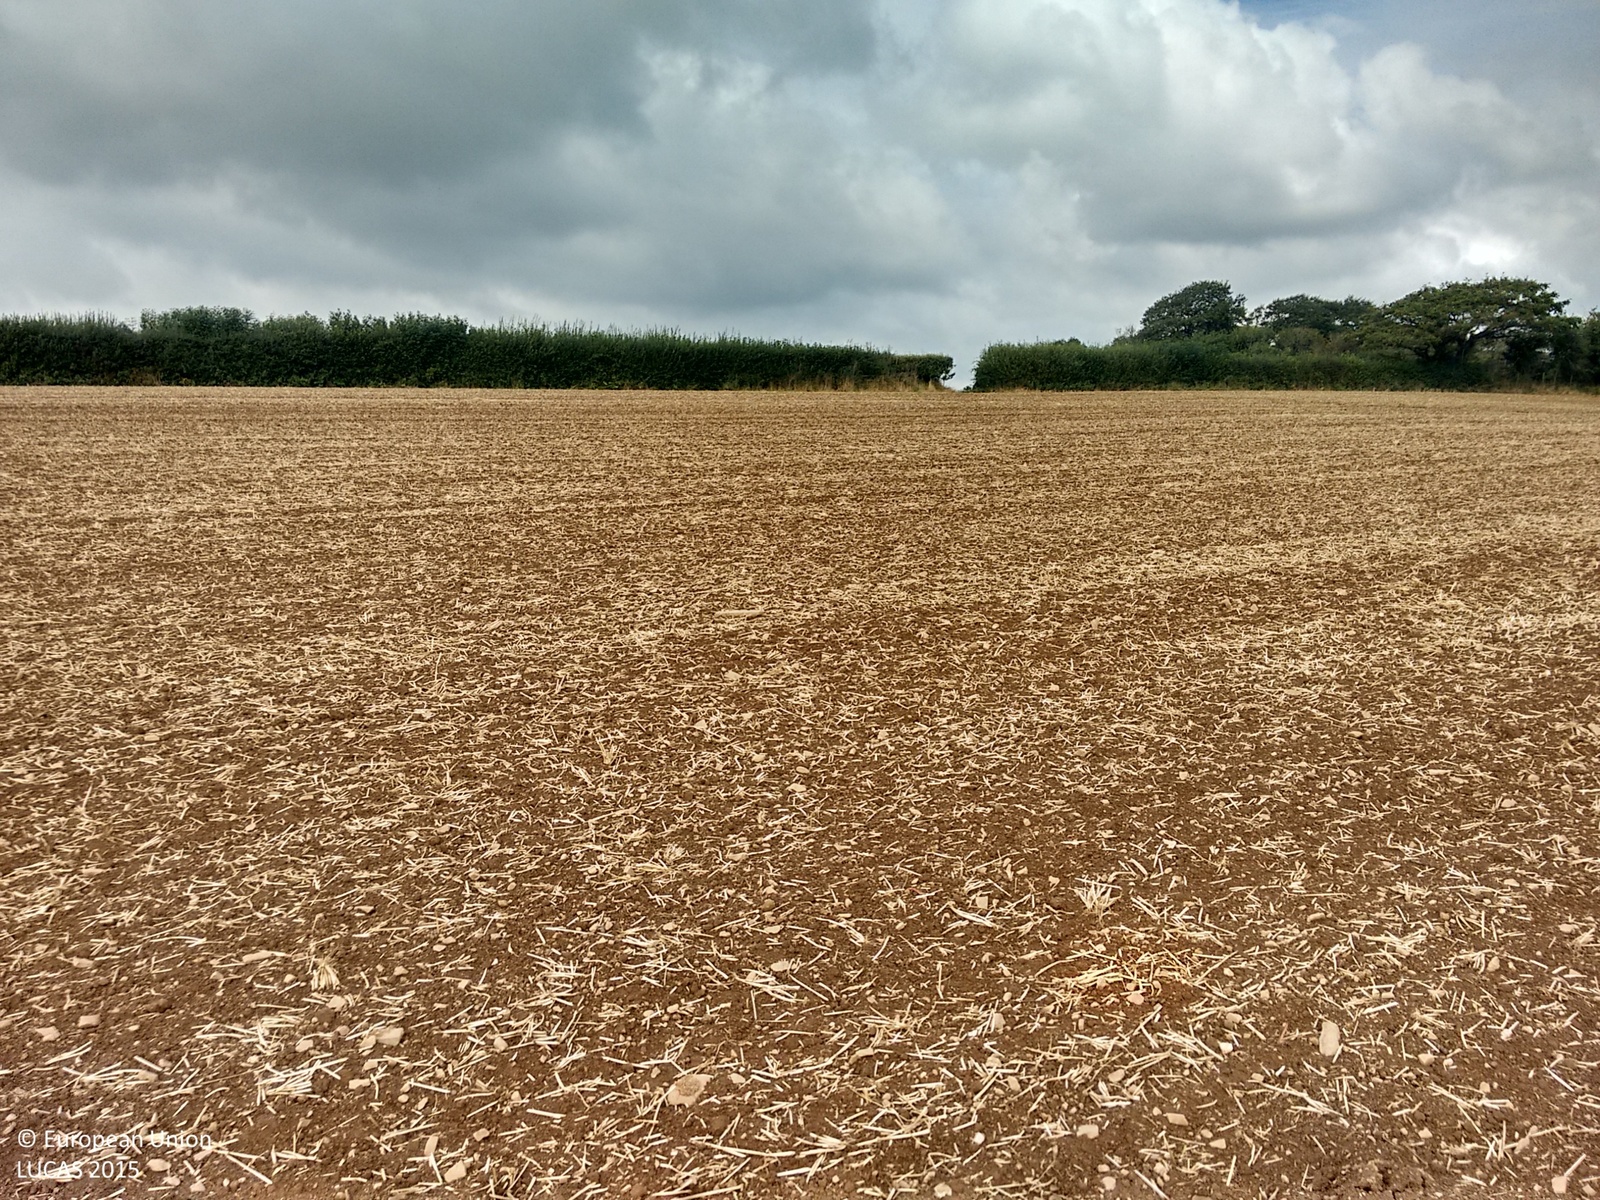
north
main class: Cropland
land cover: Barley
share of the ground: 10 - 25 %
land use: Agriculture (excluding fallow land and kitchen gardens)
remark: Harvested field
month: September
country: GB
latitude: 50.7683
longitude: -4.3514
